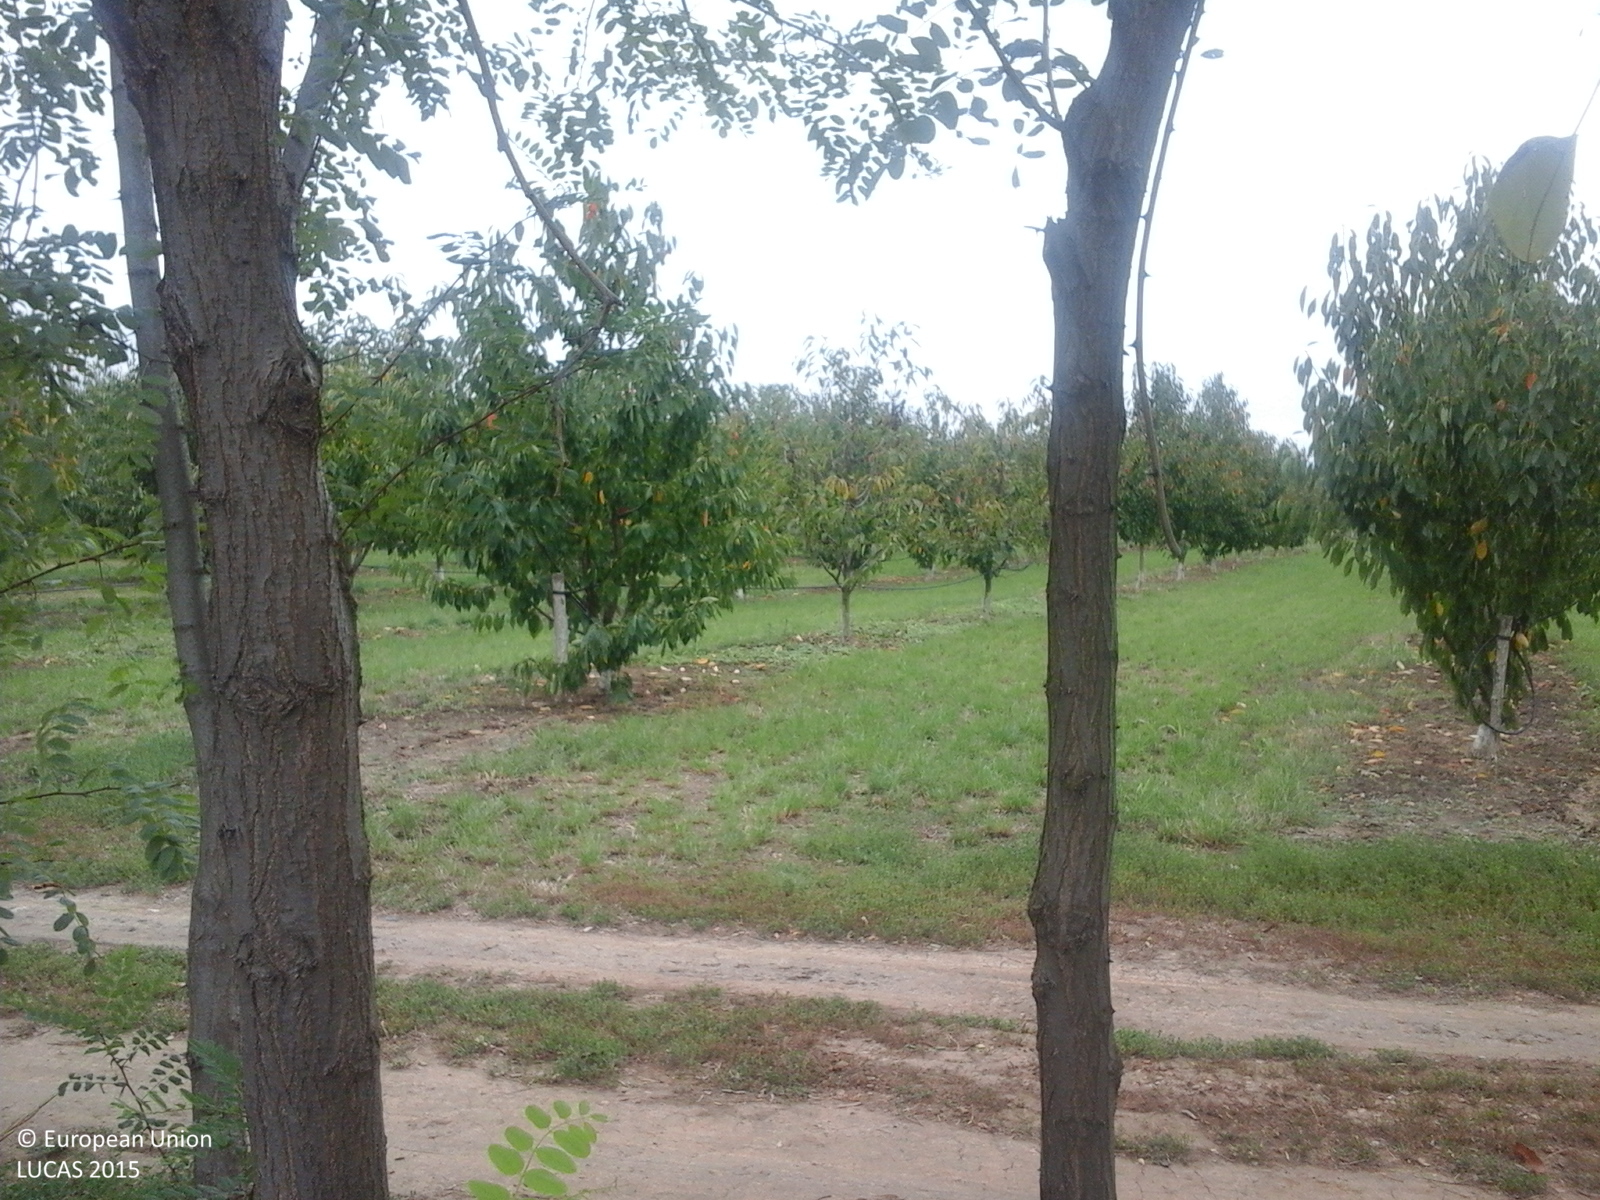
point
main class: Cropland
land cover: Cherry fruit
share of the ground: 50 - 75 %
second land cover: Grassland without tree/shrub cover
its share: > 75 %
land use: Agriculture (excluding fallow land and kitchen gardens)
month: September
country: RO
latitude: 47.3439
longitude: 22.0279
